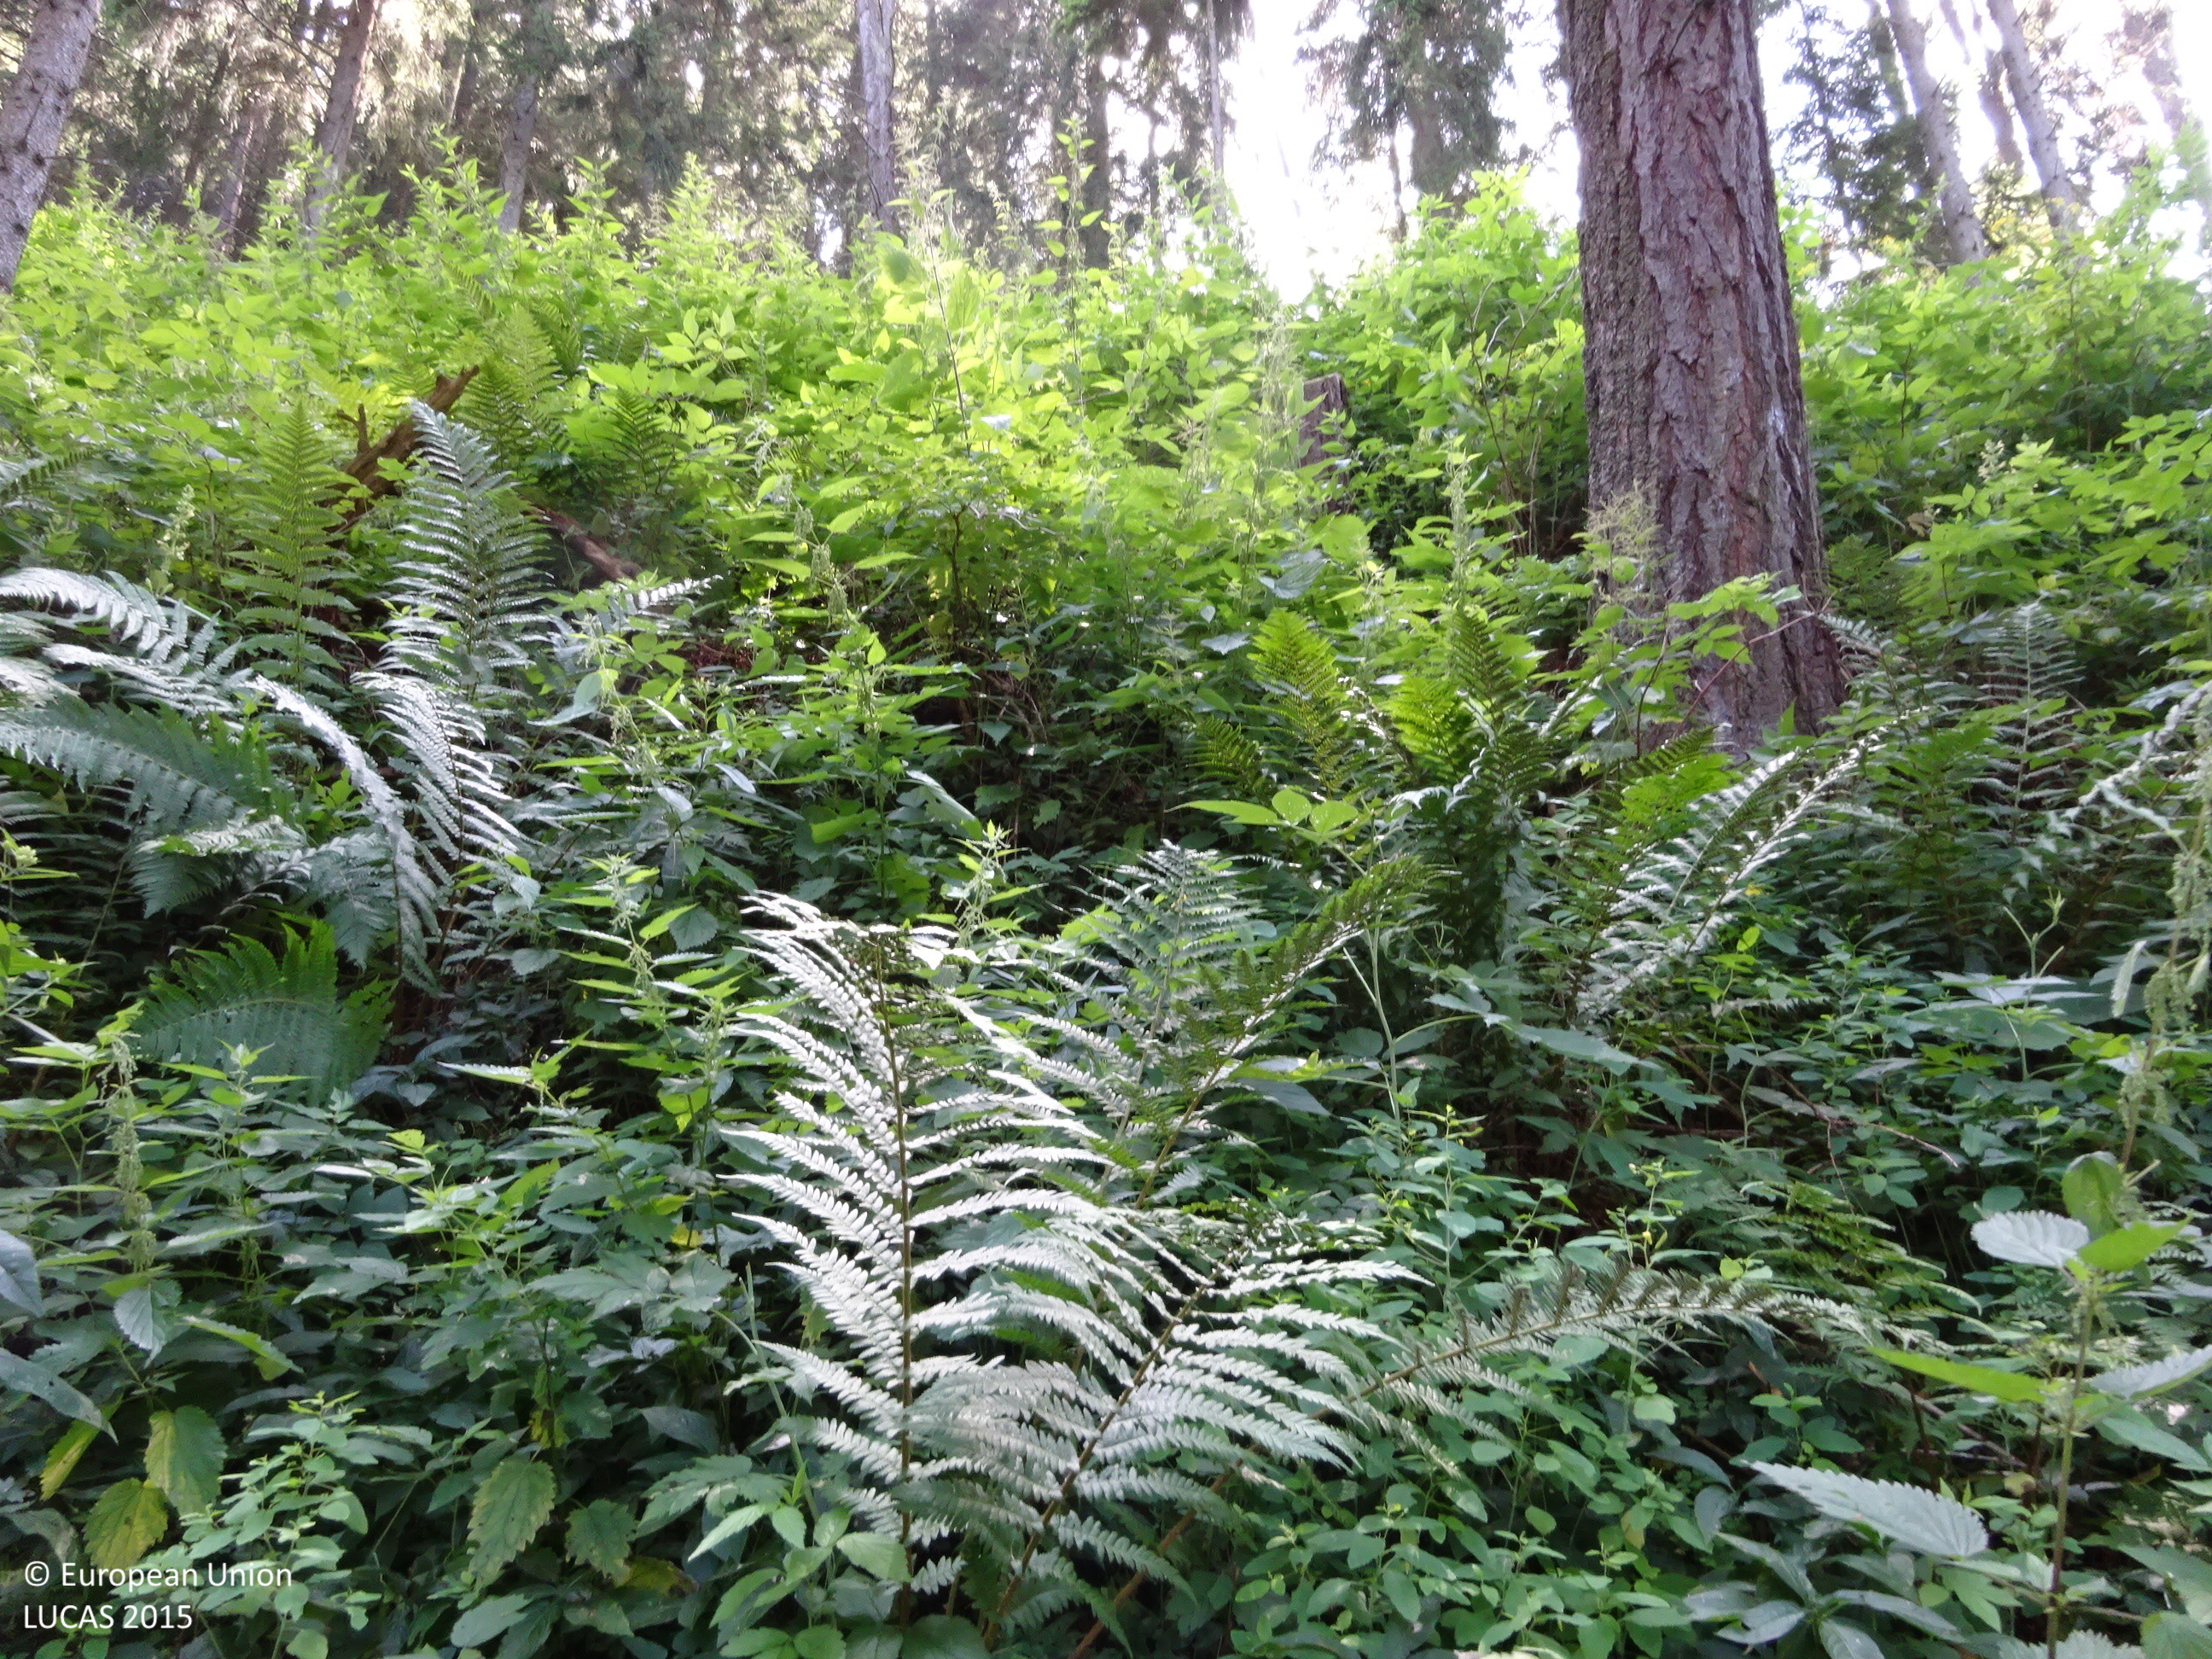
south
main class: Woodland
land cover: Spruce dominated coniferous woodland
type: alpine coniferous forest
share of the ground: > 75 %
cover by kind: coniferous forest trees 85 %, herbaceous plants 10 %, shrubs 5 %
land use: Forestry
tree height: > 5 m
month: August
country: AT
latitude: 47.3636
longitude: 15.5222
